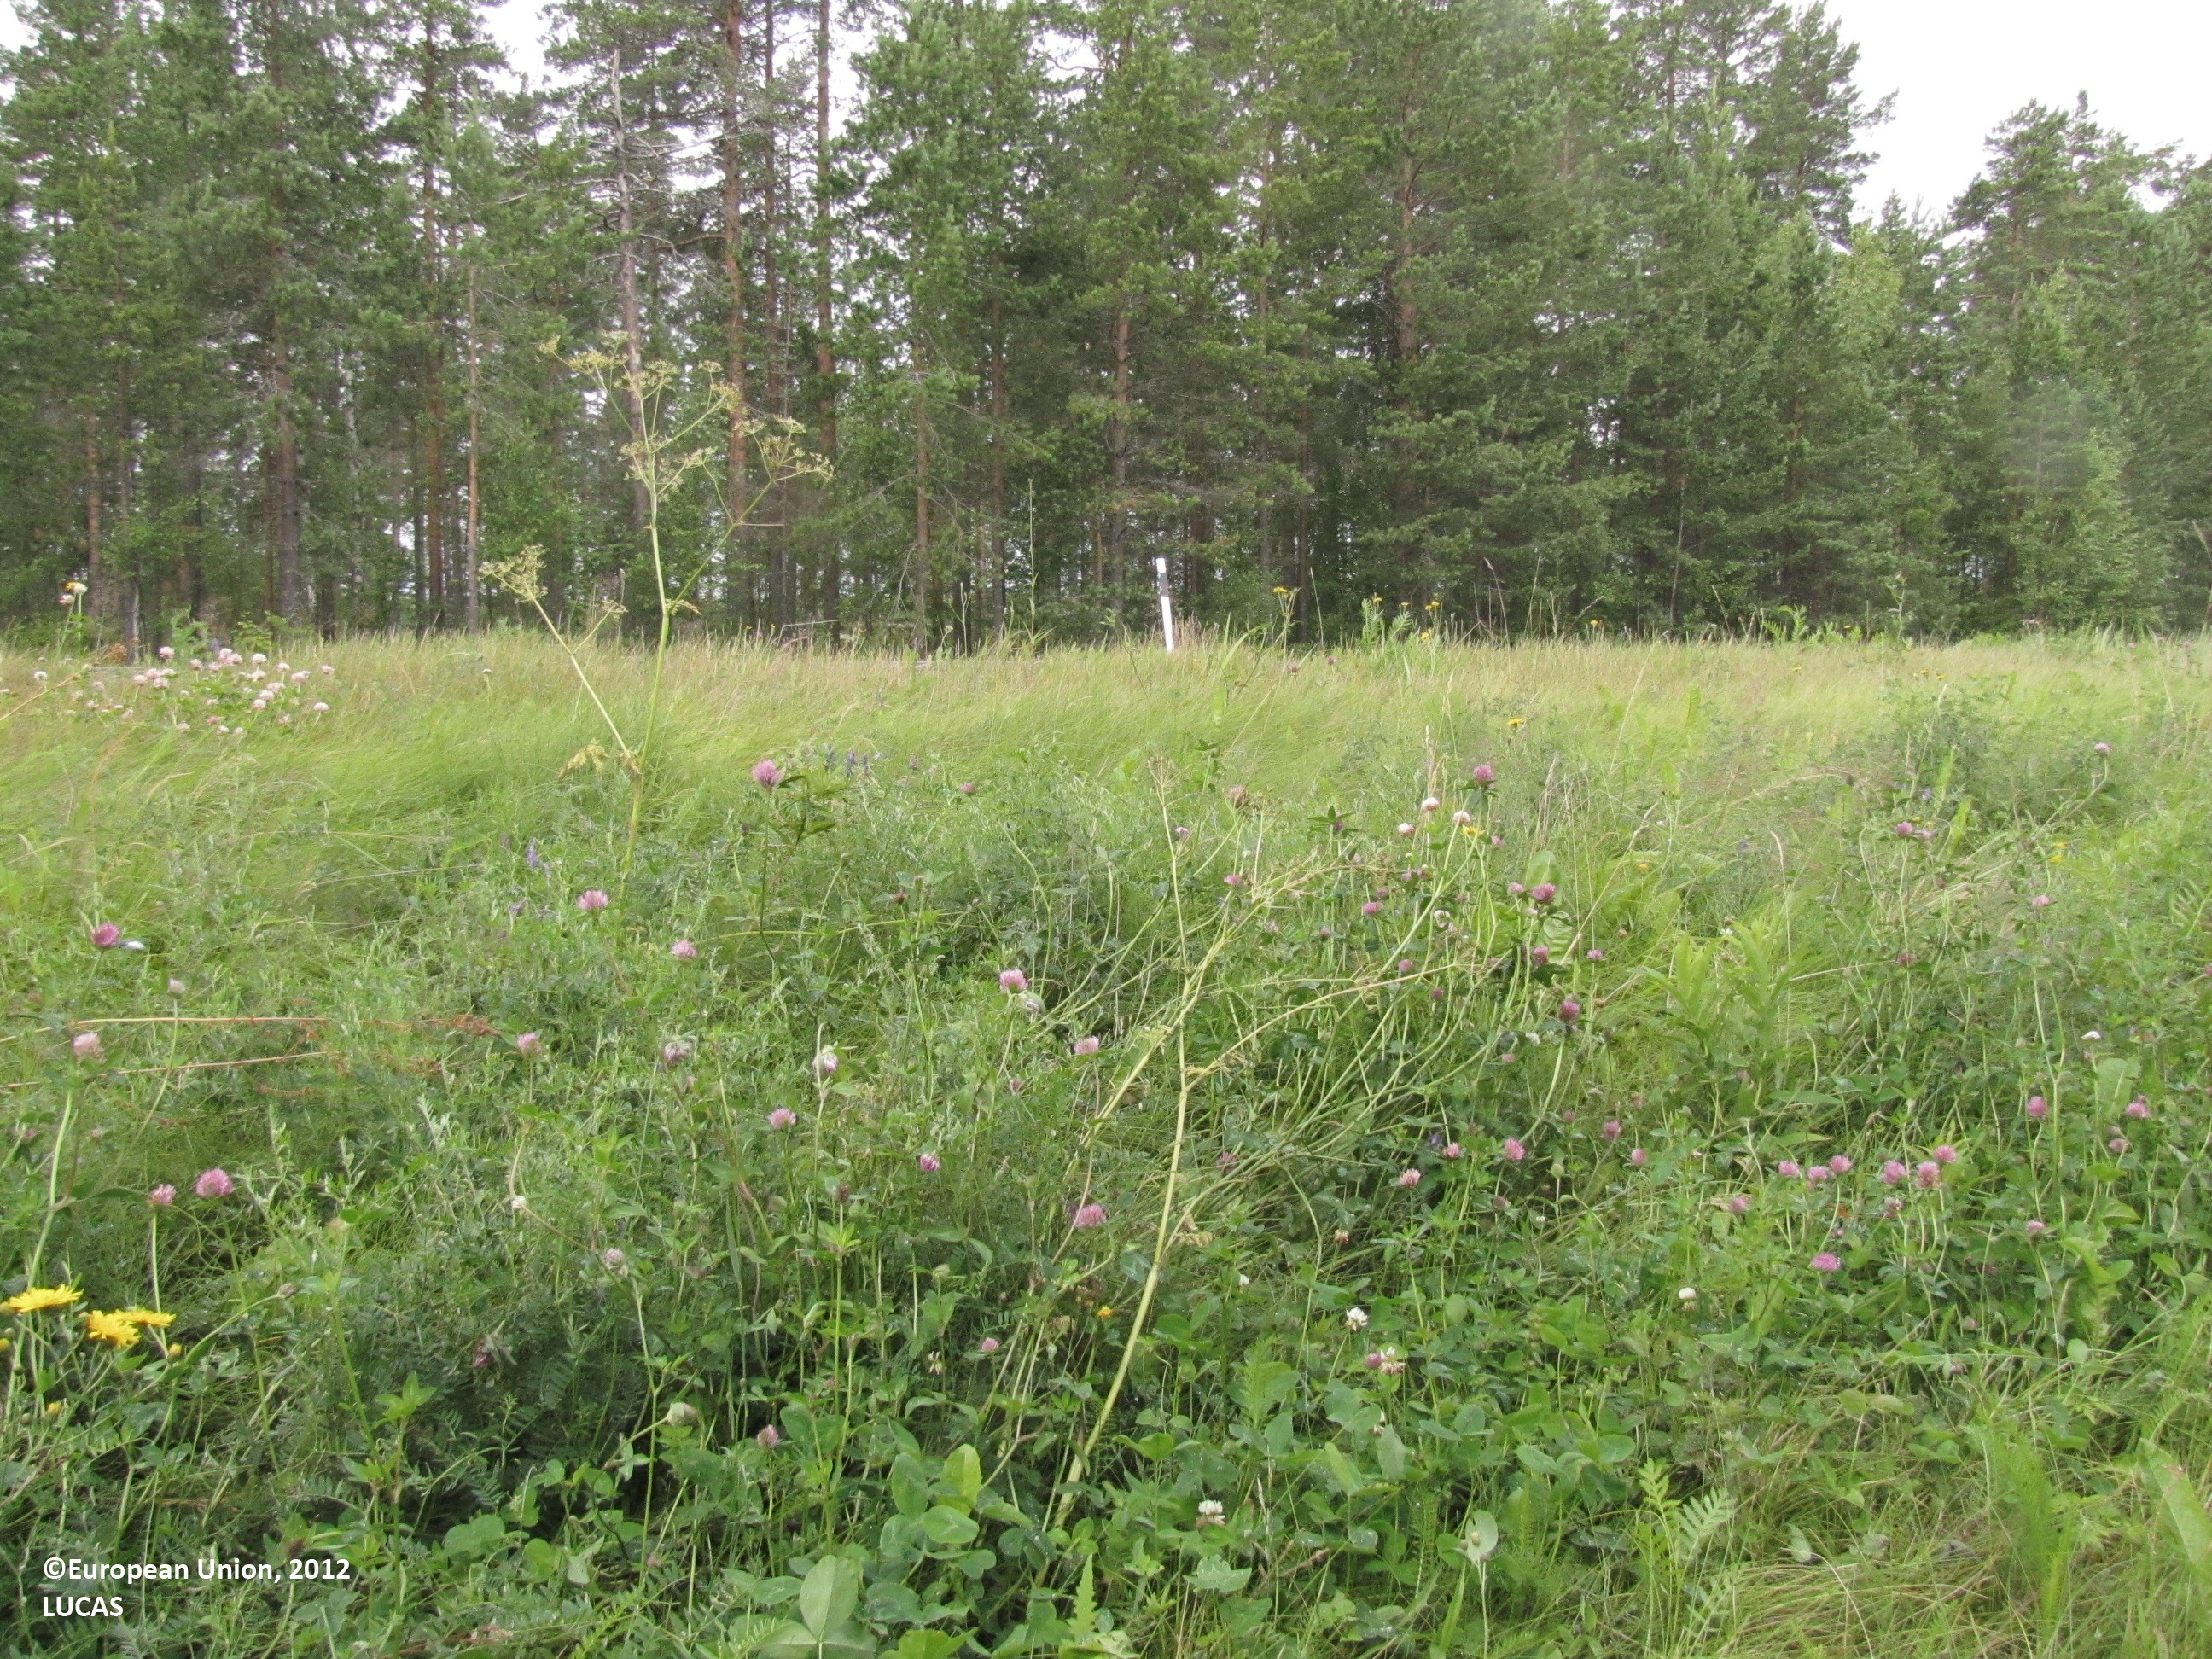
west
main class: Grassland
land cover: Grassland without tree/shrub cover
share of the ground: > 75 %
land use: Road transport
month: July
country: FI
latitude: 62.2731
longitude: 22.9143
